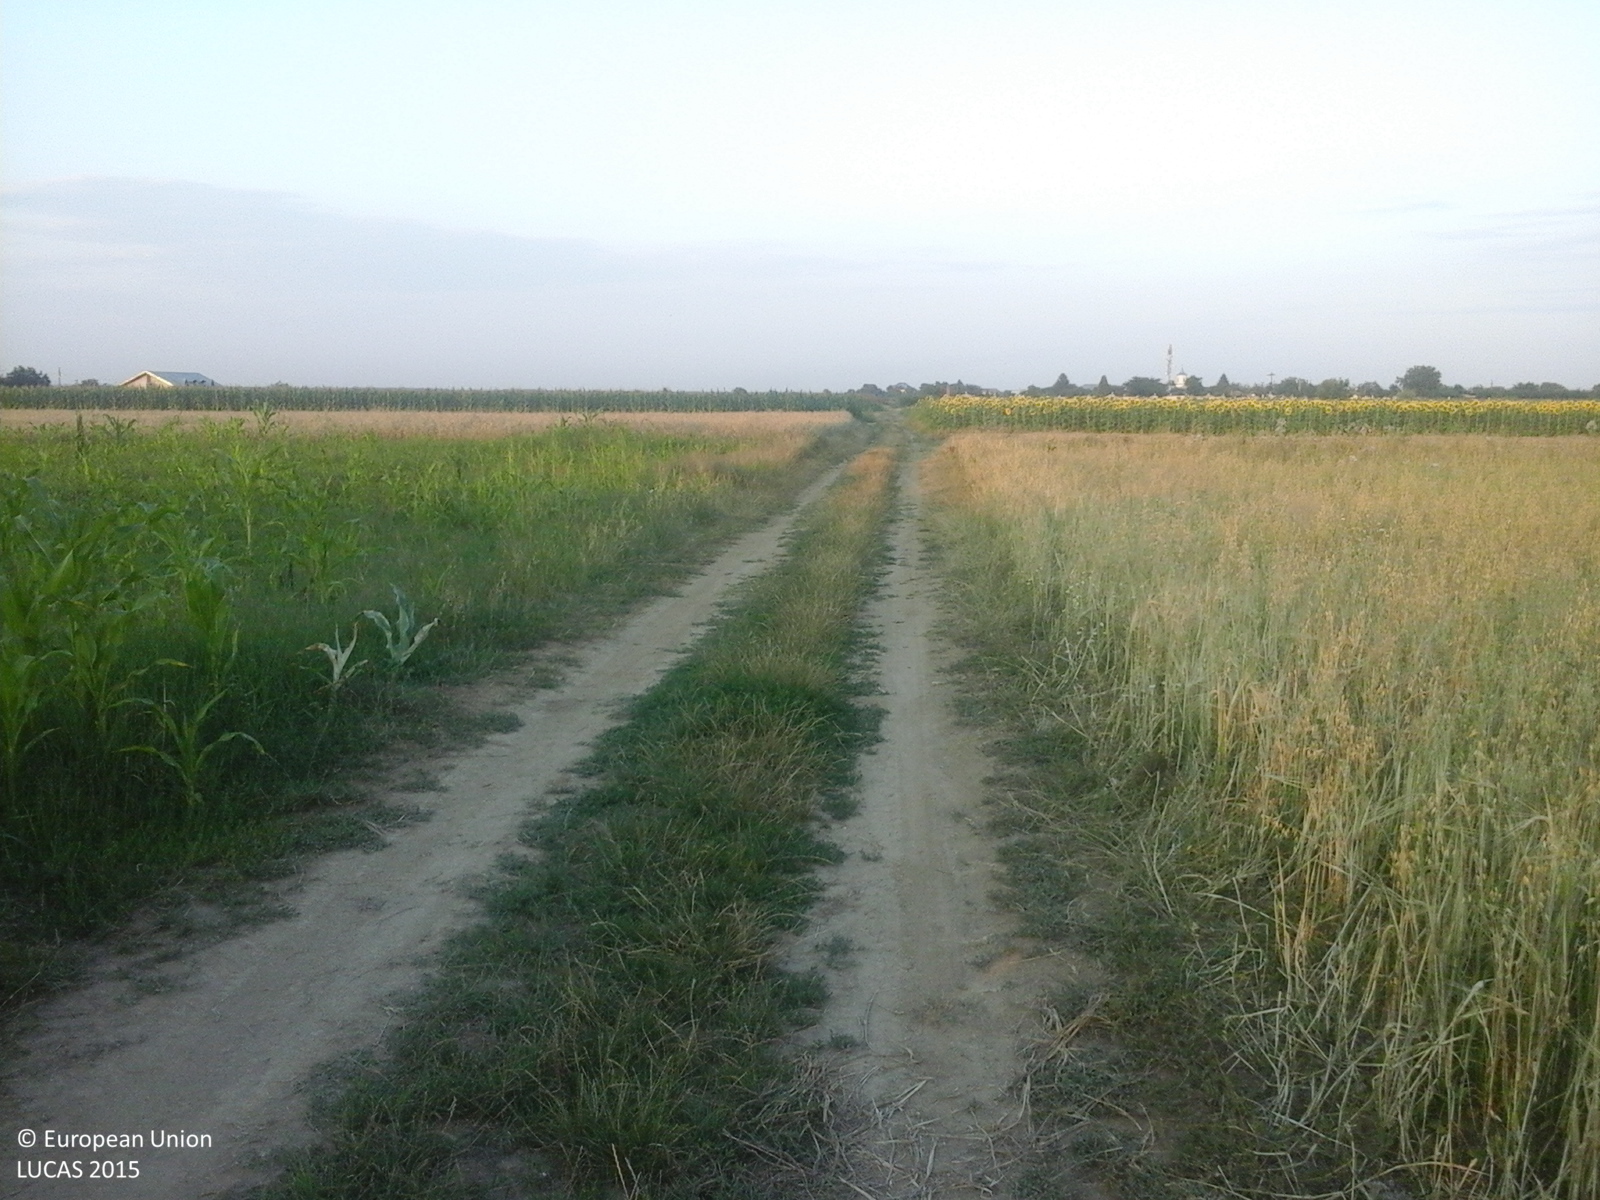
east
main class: Cropland
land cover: Maize
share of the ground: > 75 %
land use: Agriculture (excluding fallow land and kitchen gardens)
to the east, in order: Maize; Common wheat; Maize; Spontaneously vegetated surfaces; Maize; Common wheat
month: July
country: RO
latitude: 44.3628
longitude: 24.2822
